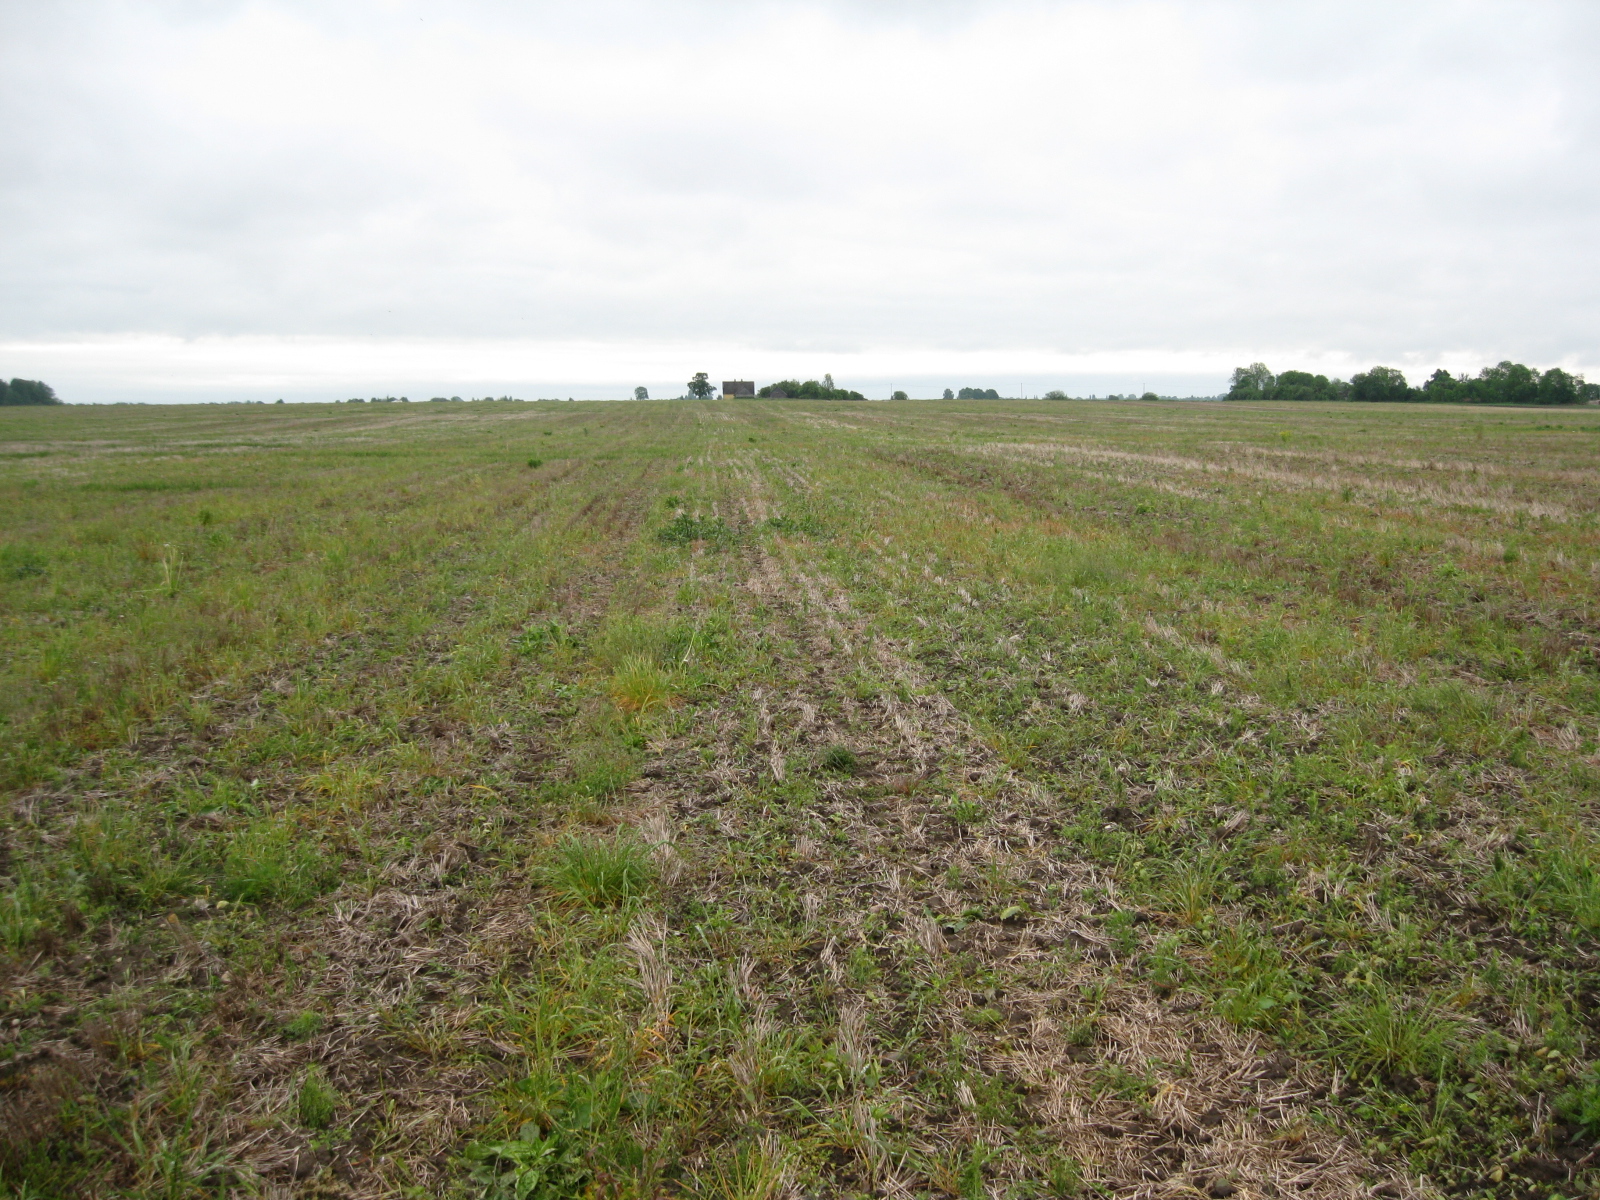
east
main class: Grassland
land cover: Spontaneously vegetated surfaces
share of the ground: 50 - 75 %
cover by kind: herbaceous plants 70 %, unconsolidated bare surface 30 %
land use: Fallow land
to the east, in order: Spontaneously vegetated surfaces
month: June
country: LT
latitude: 55.9380
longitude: 24.0648
